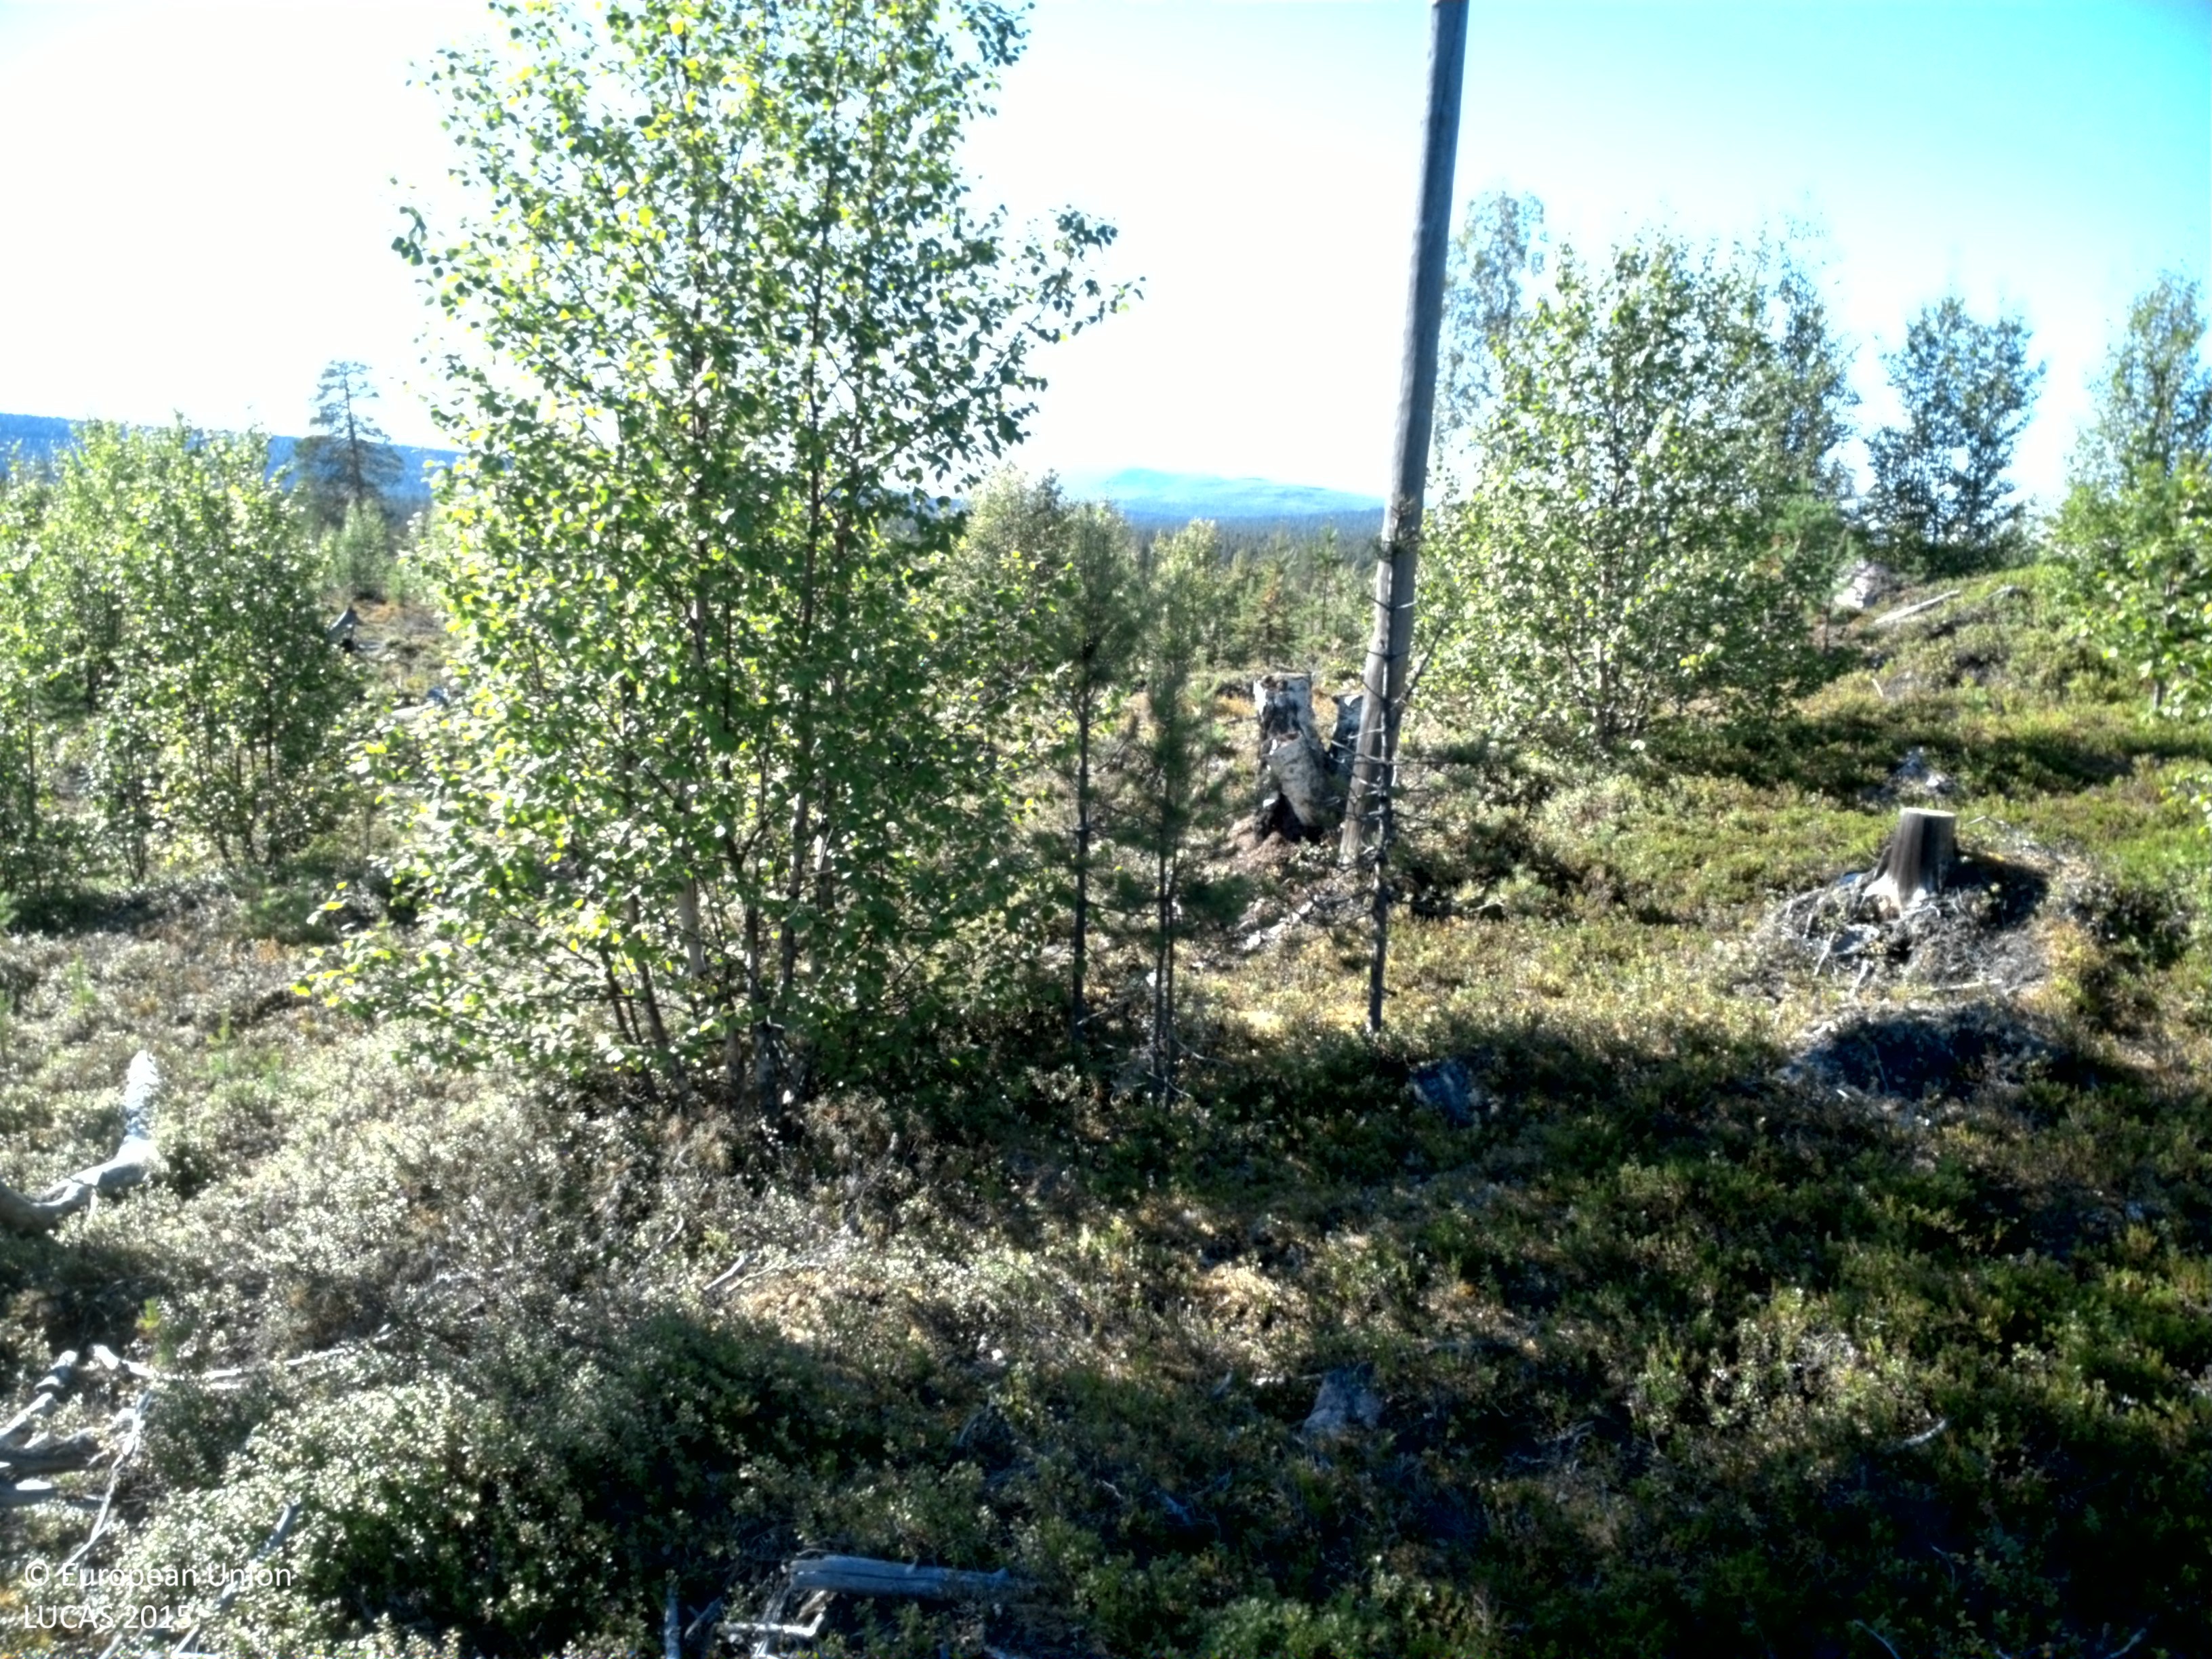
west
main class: Woodland
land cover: Pine dominated mixed woodland
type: boreal forest
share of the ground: 25 - 50 %
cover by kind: shrubs 55 %, broadleaved forest trees 20 %, coniferous forest trees 10 %, lichens and mosses 10 %, consolidated bare surface 5 %
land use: Forestry
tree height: < 5 m
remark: Clear cut
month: August
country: SE
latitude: 66.8101
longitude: 18.8464
